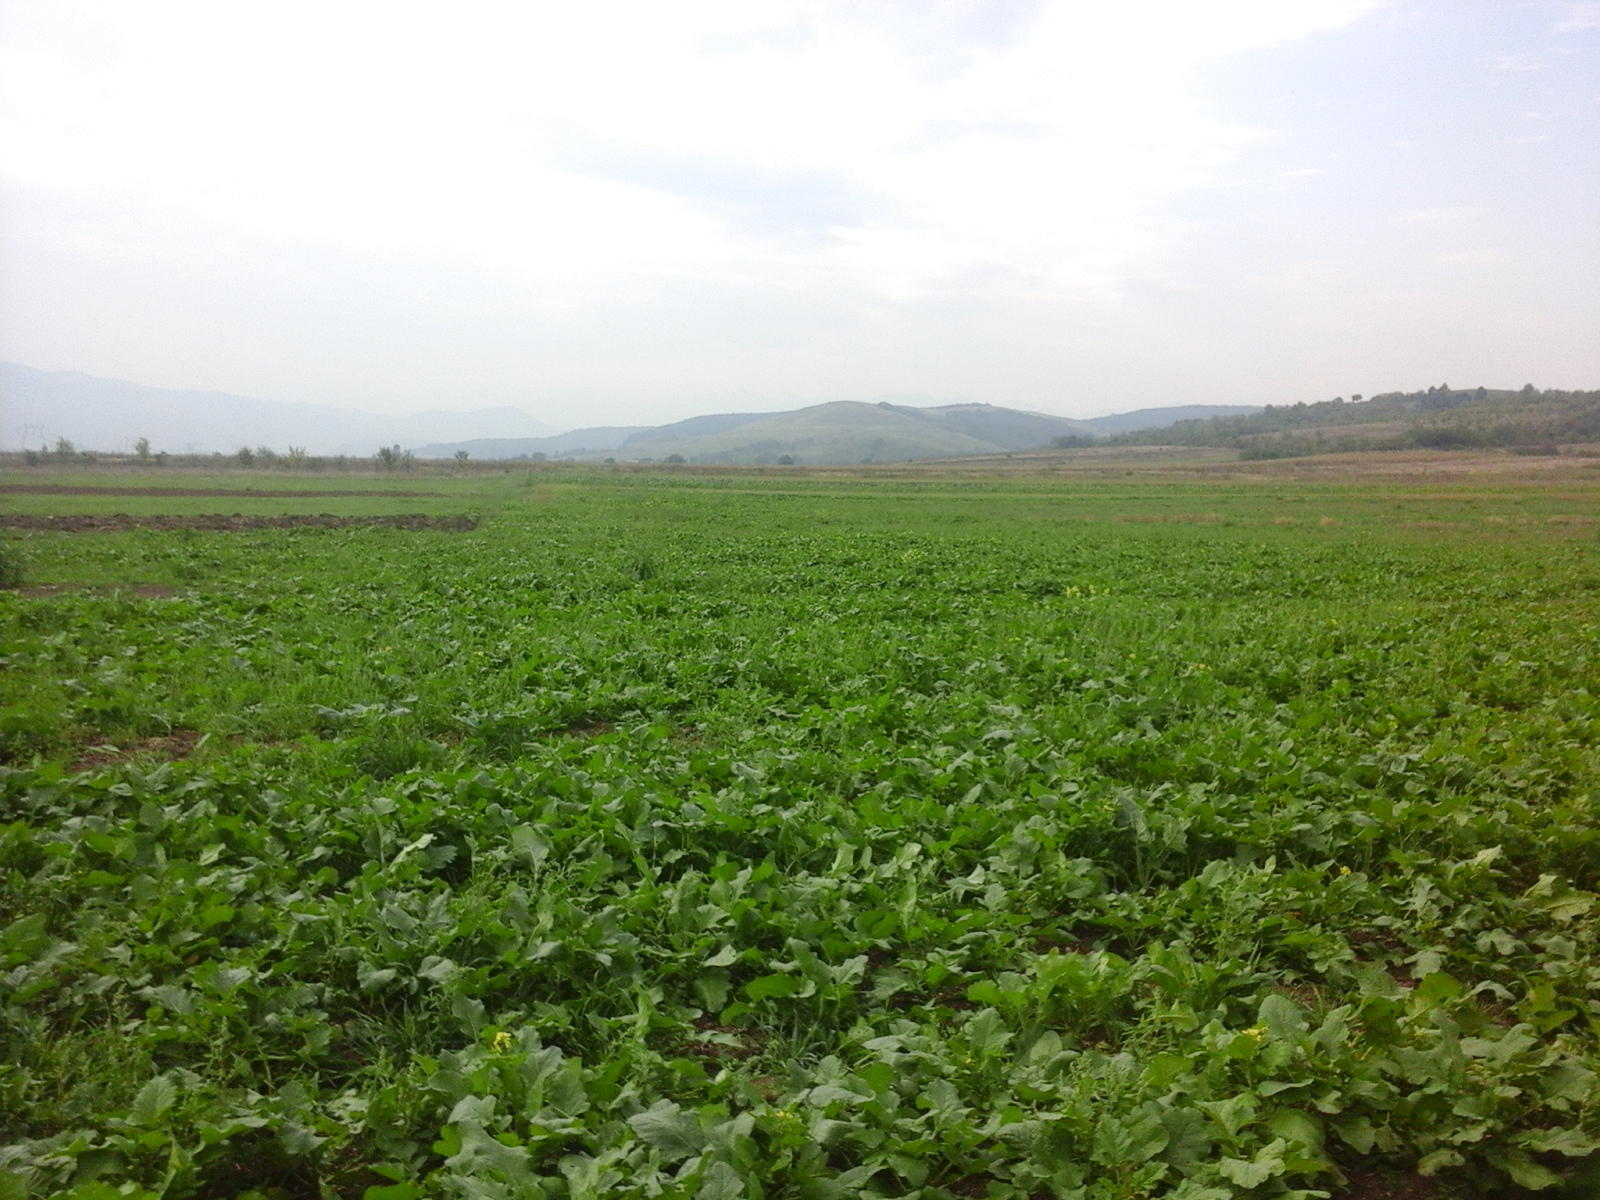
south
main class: Cropland
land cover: Sugar beet
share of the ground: > 75 %
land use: Agriculture (excluding fallow land and kitchen gardens)
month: September
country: RO
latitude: 45.6836
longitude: 22.9831
